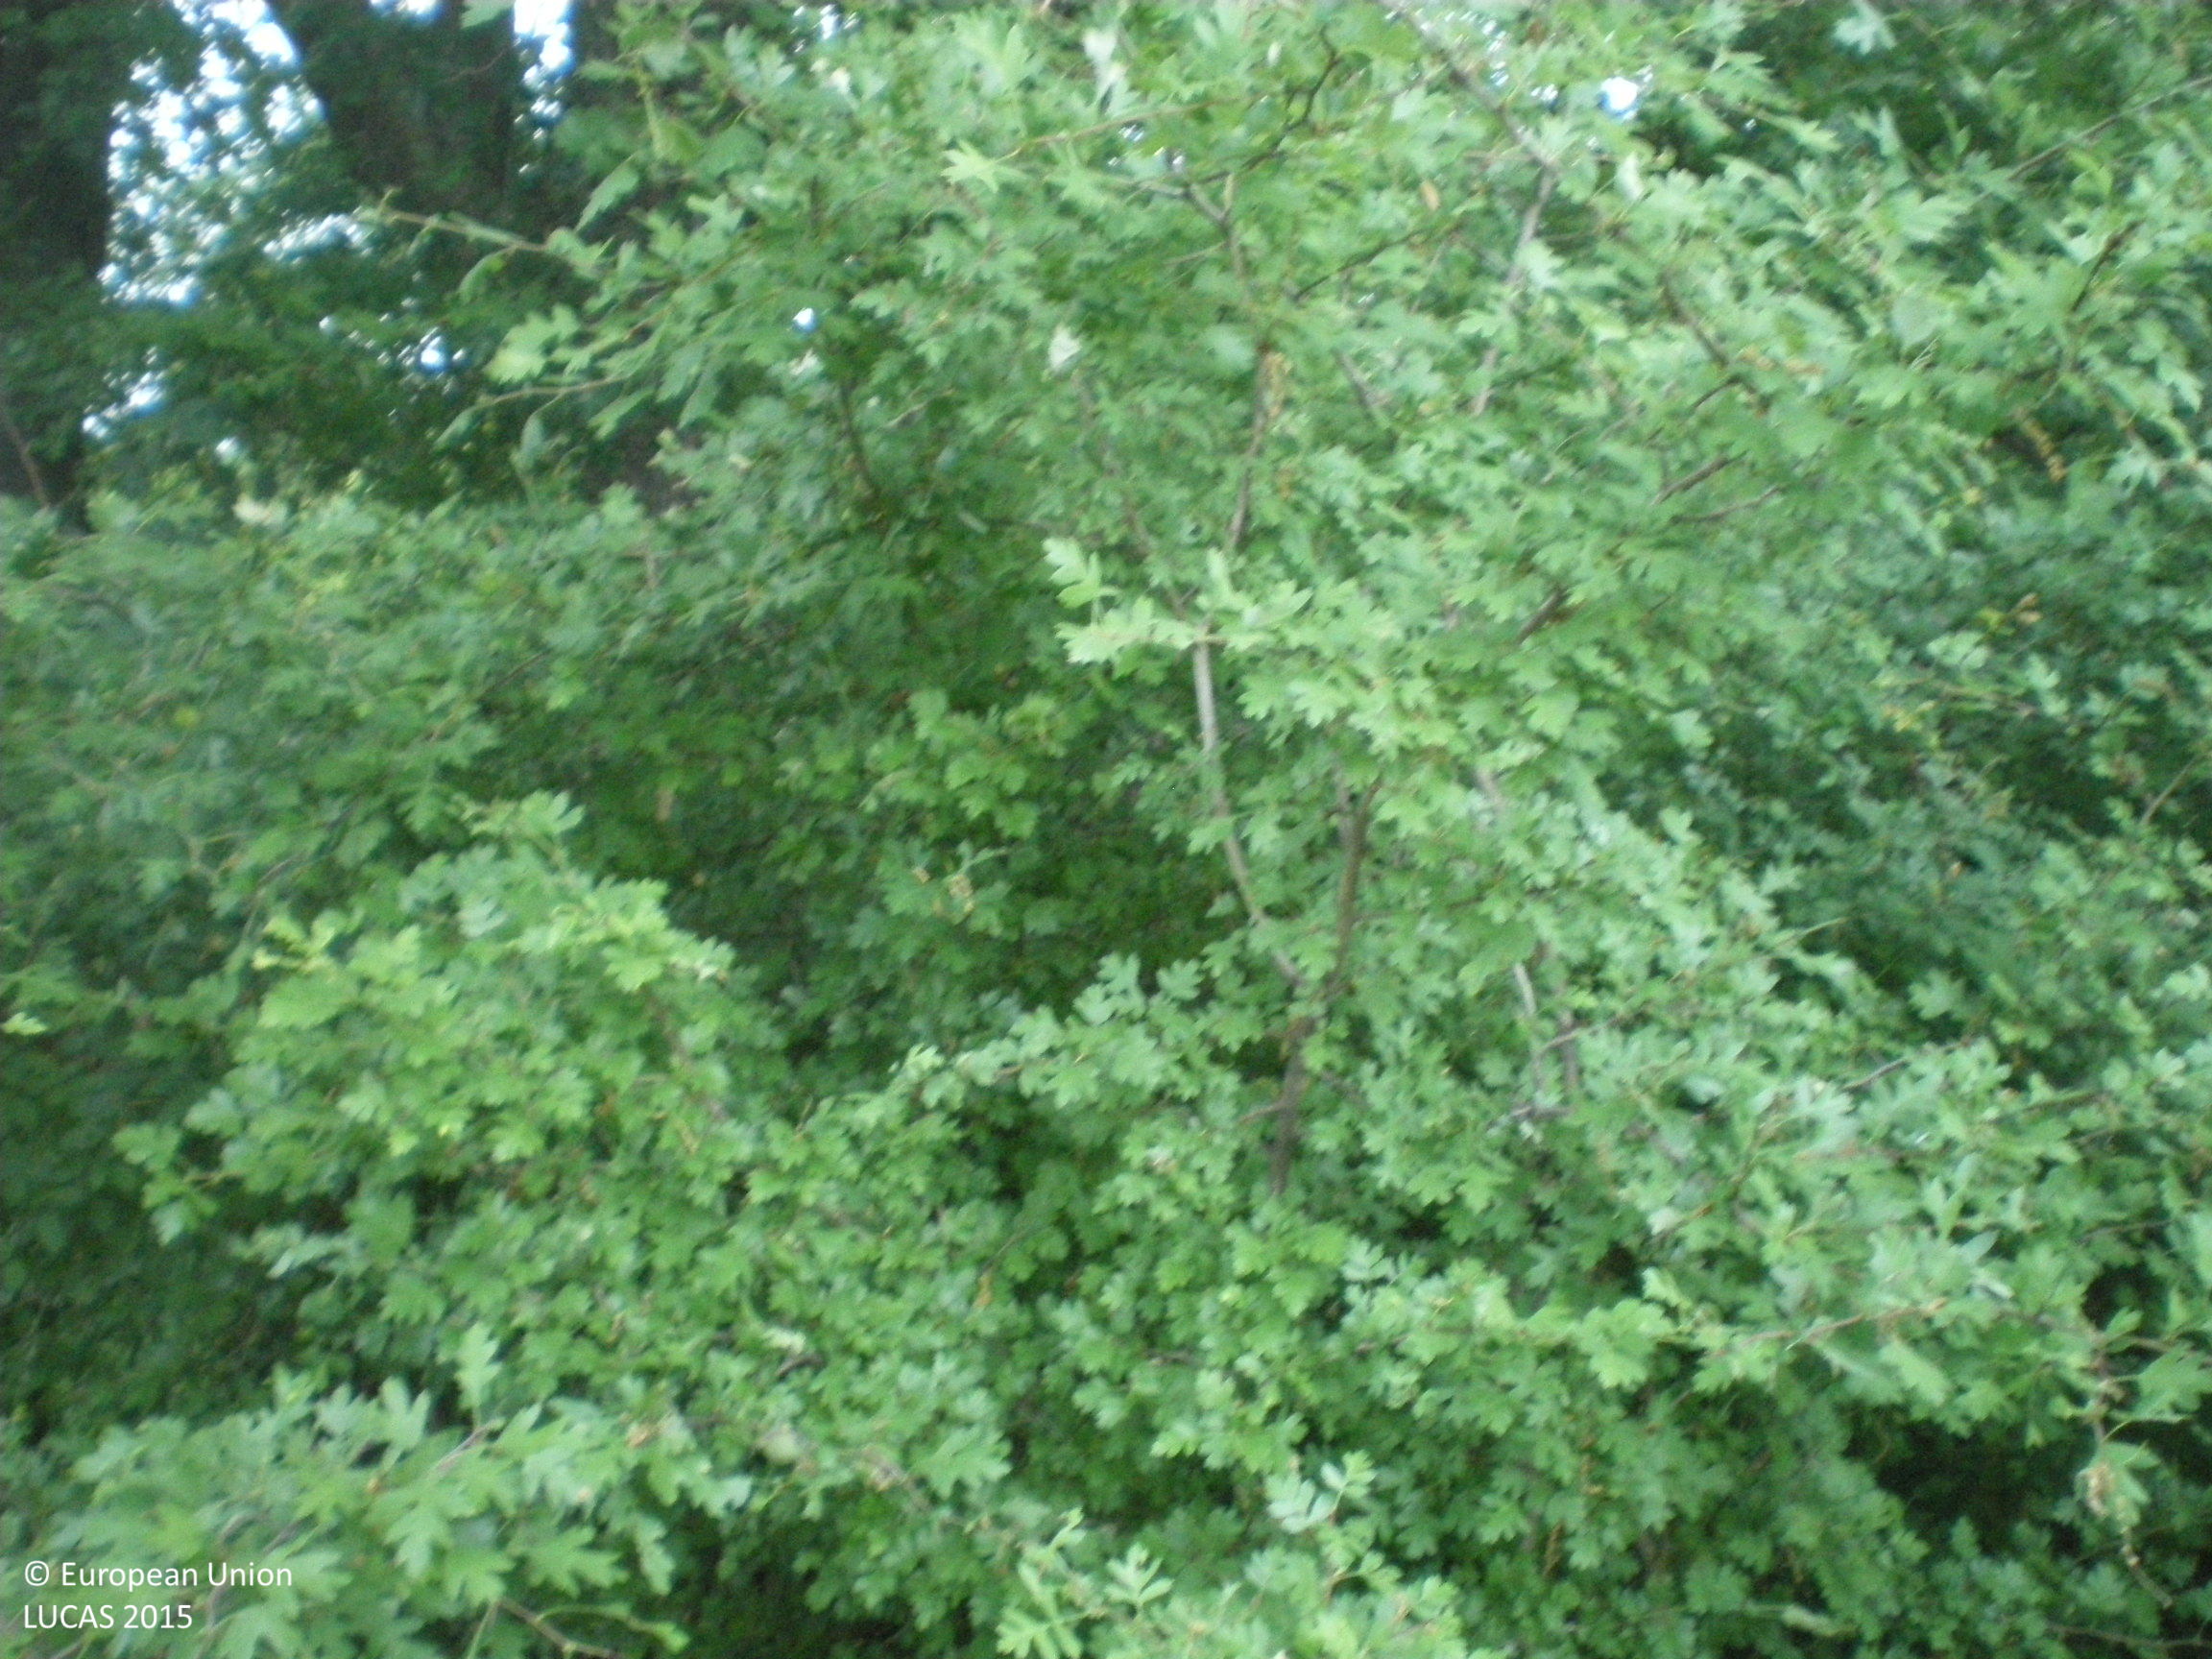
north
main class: Woodland
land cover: Broadleaved woodland
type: mesophytic deciduous forest
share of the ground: > 75 %
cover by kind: broadleaved forest trees 70 %, shrubs 20 %, herbaceous plants 10 %
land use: Forestry
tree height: > 5 m
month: May
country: BG
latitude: 42.2786
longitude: 25.3800
